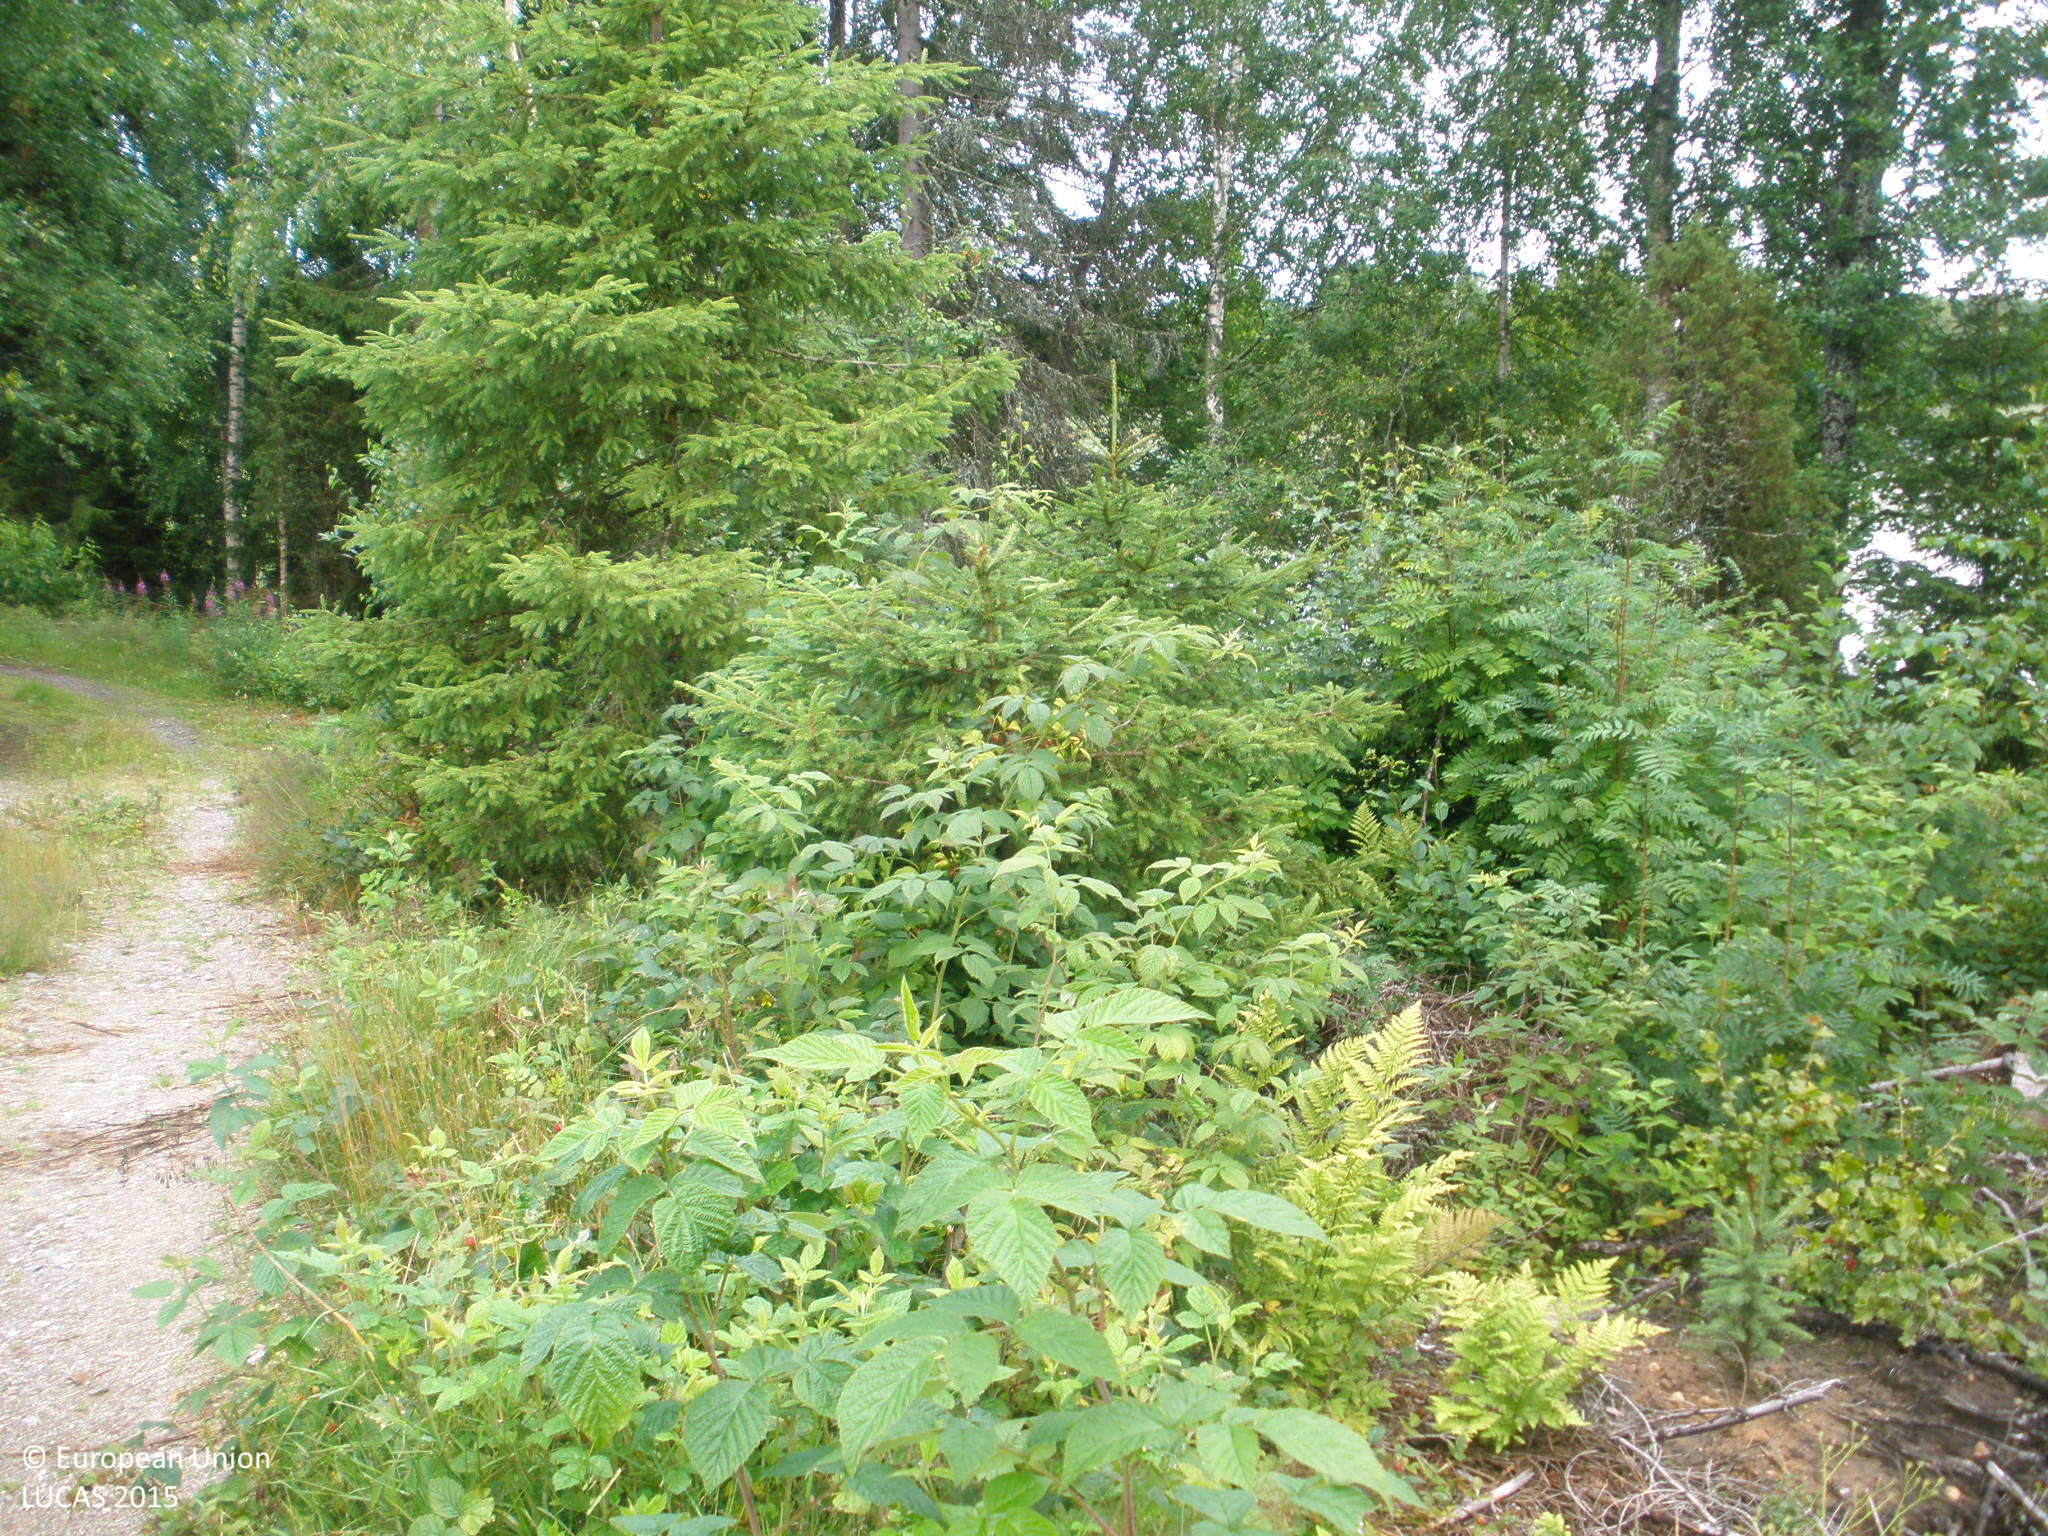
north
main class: Shrubland
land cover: Shrubland with sparse tree cover
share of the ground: 50 - 75 %
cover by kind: shrubs 65 %, herbaceous plants 10 %, consolidated bare surface 10 %, unconsolidated bare surface 10 %, broadleaved forest trees 5 %
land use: Forestry
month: July
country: FI
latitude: 61.2984
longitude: 24.6823
